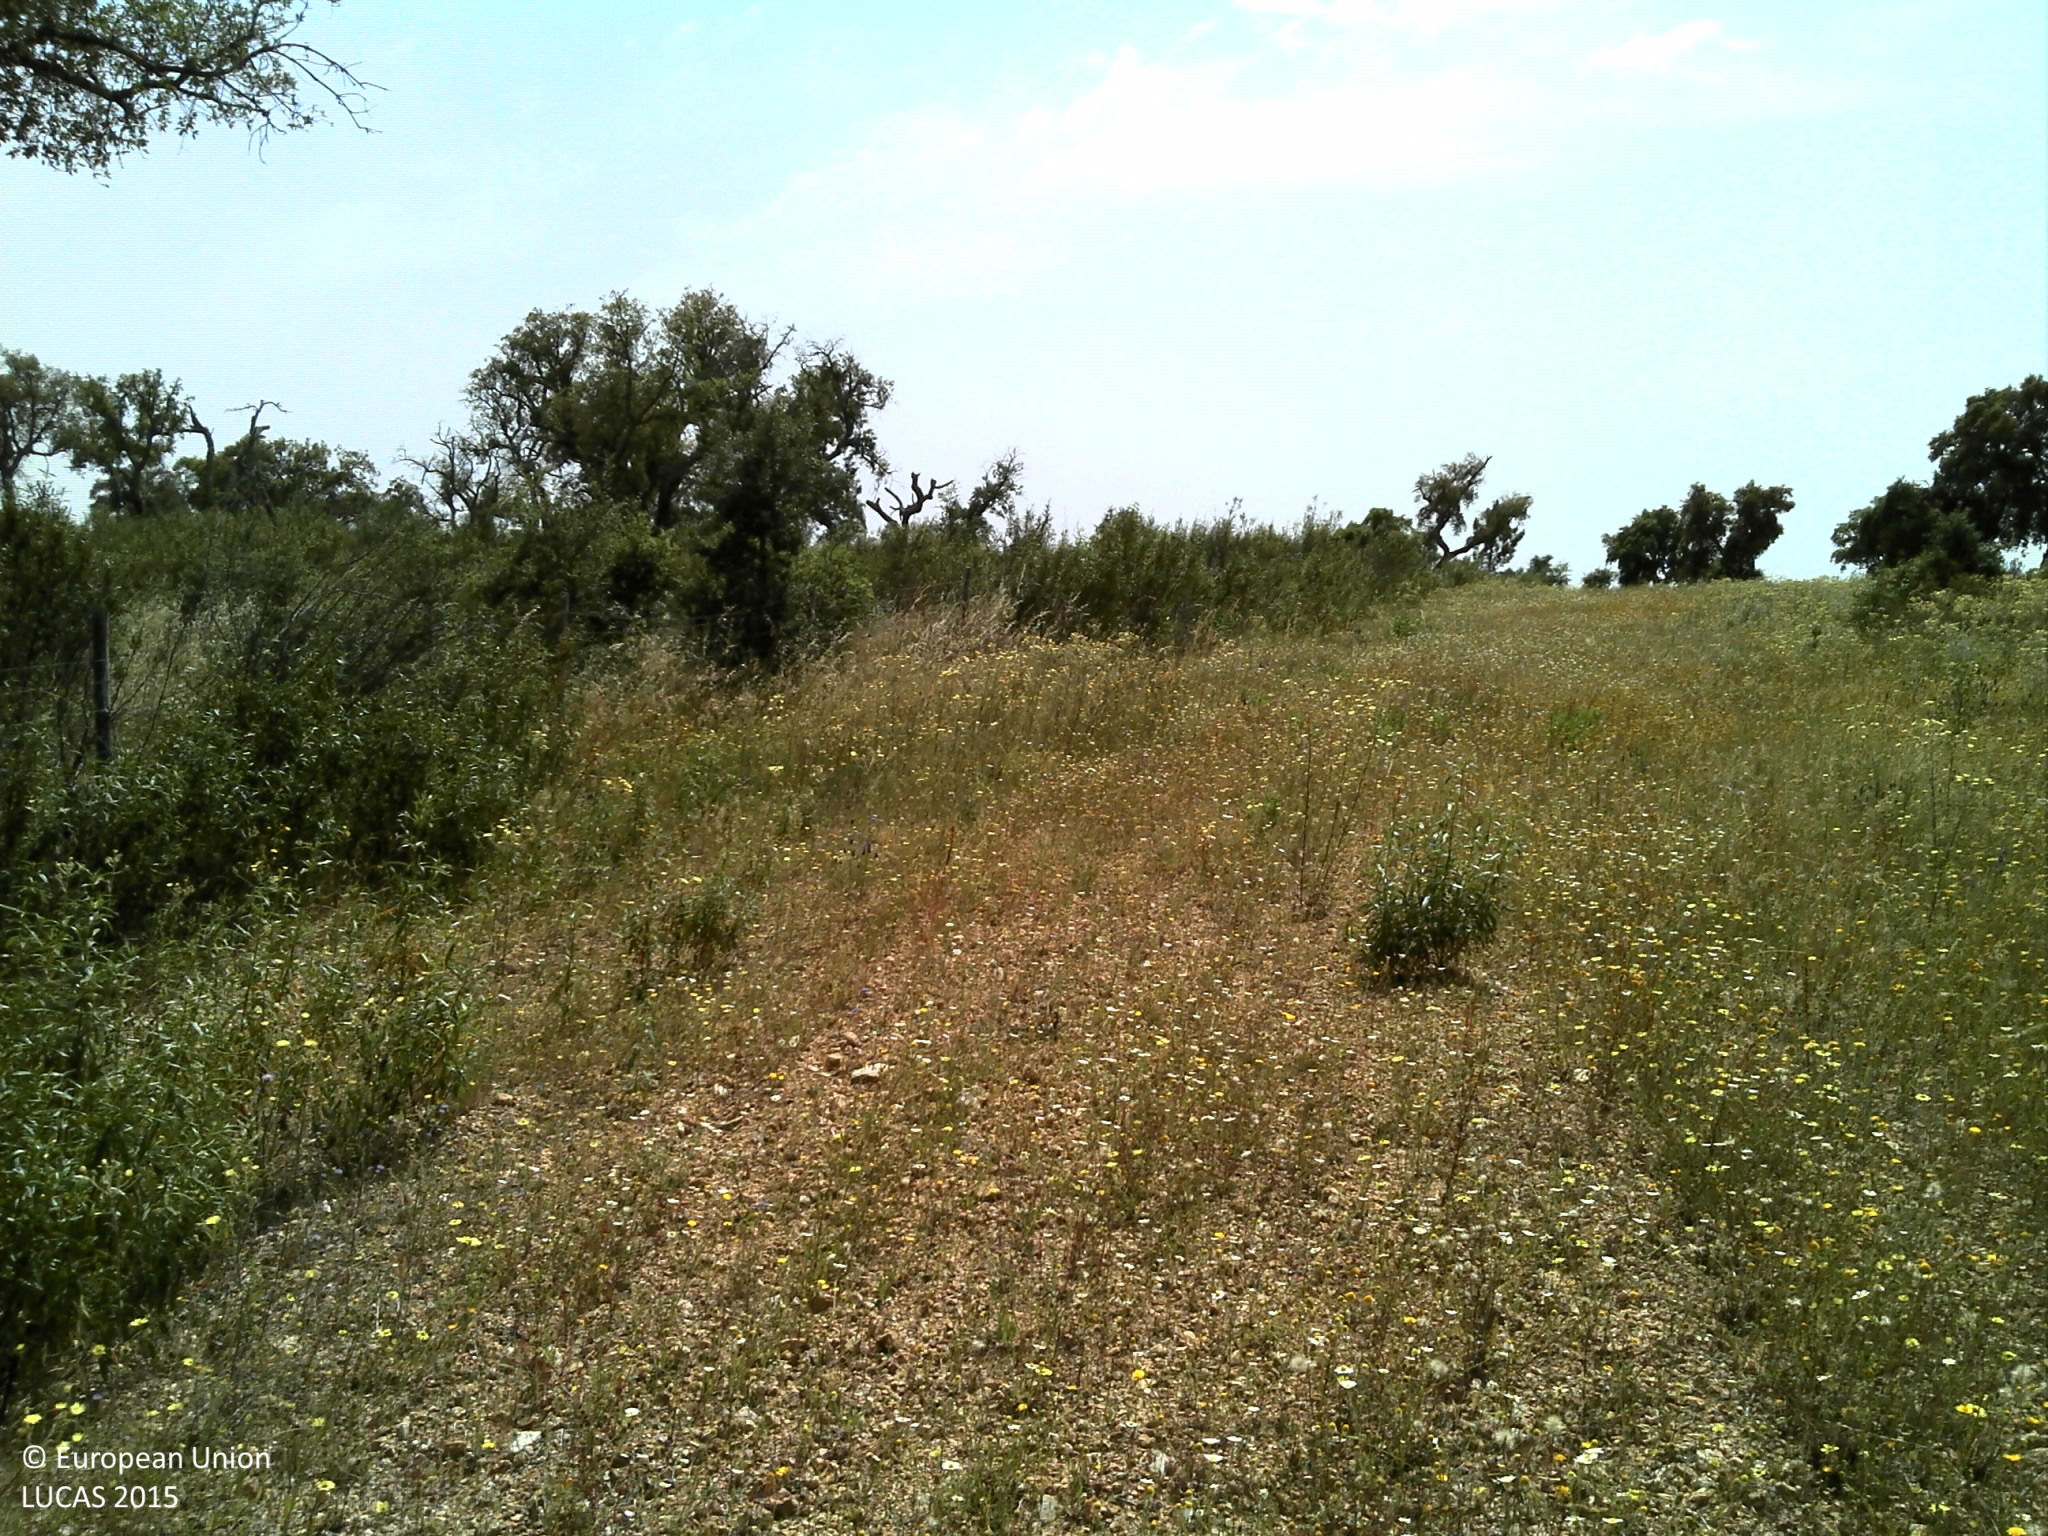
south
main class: Woodland
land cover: Broadleaved woodland
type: broadleaved evergreen forest
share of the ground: 10 - 25 %
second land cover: Grassland without tree/shrub cover
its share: 10 - 25 %
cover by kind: herbaceous plants 30 %, unconsolidated bare surface 30 %, shrubs 25 %, broadleaved forest trees 15 %
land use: Forestry
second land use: Agriculture (excluding fallow land and kitchen gardens)
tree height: > 5 m
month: May
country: PT
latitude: 39.0058
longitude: -7.9357
